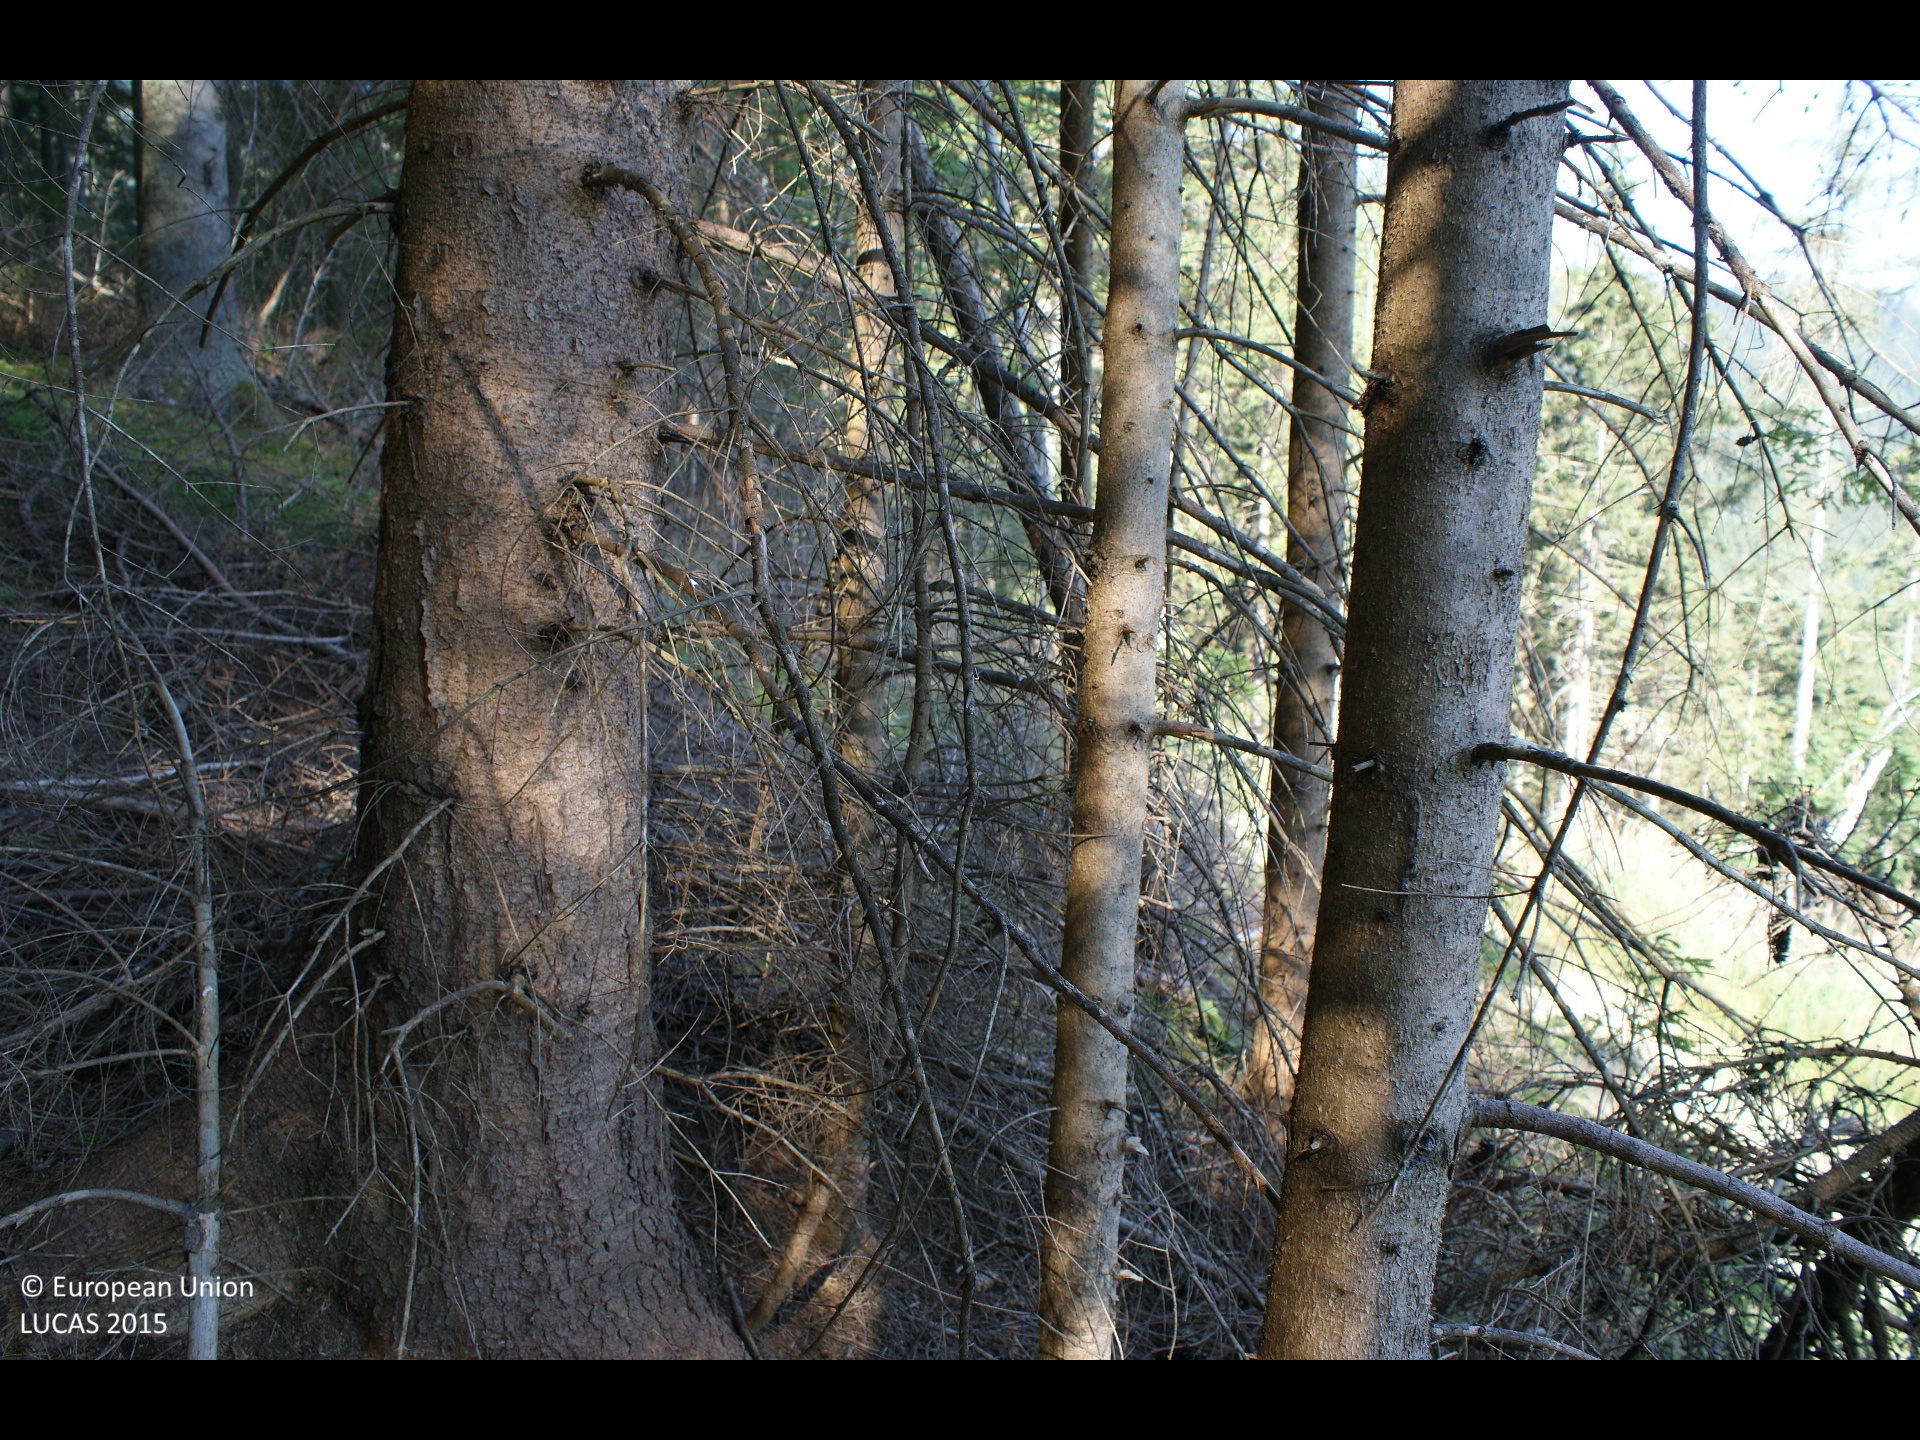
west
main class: Woodland
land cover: Spruce dominated coniferous woodland
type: alpine coniferous forest
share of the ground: > 75 %
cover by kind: coniferous forest trees 85 %, lichens and mosses 10 %, shrubs 5 %
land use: Forestry
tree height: > 5 m
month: August
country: AT
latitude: 47.5969
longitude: 15.5472
